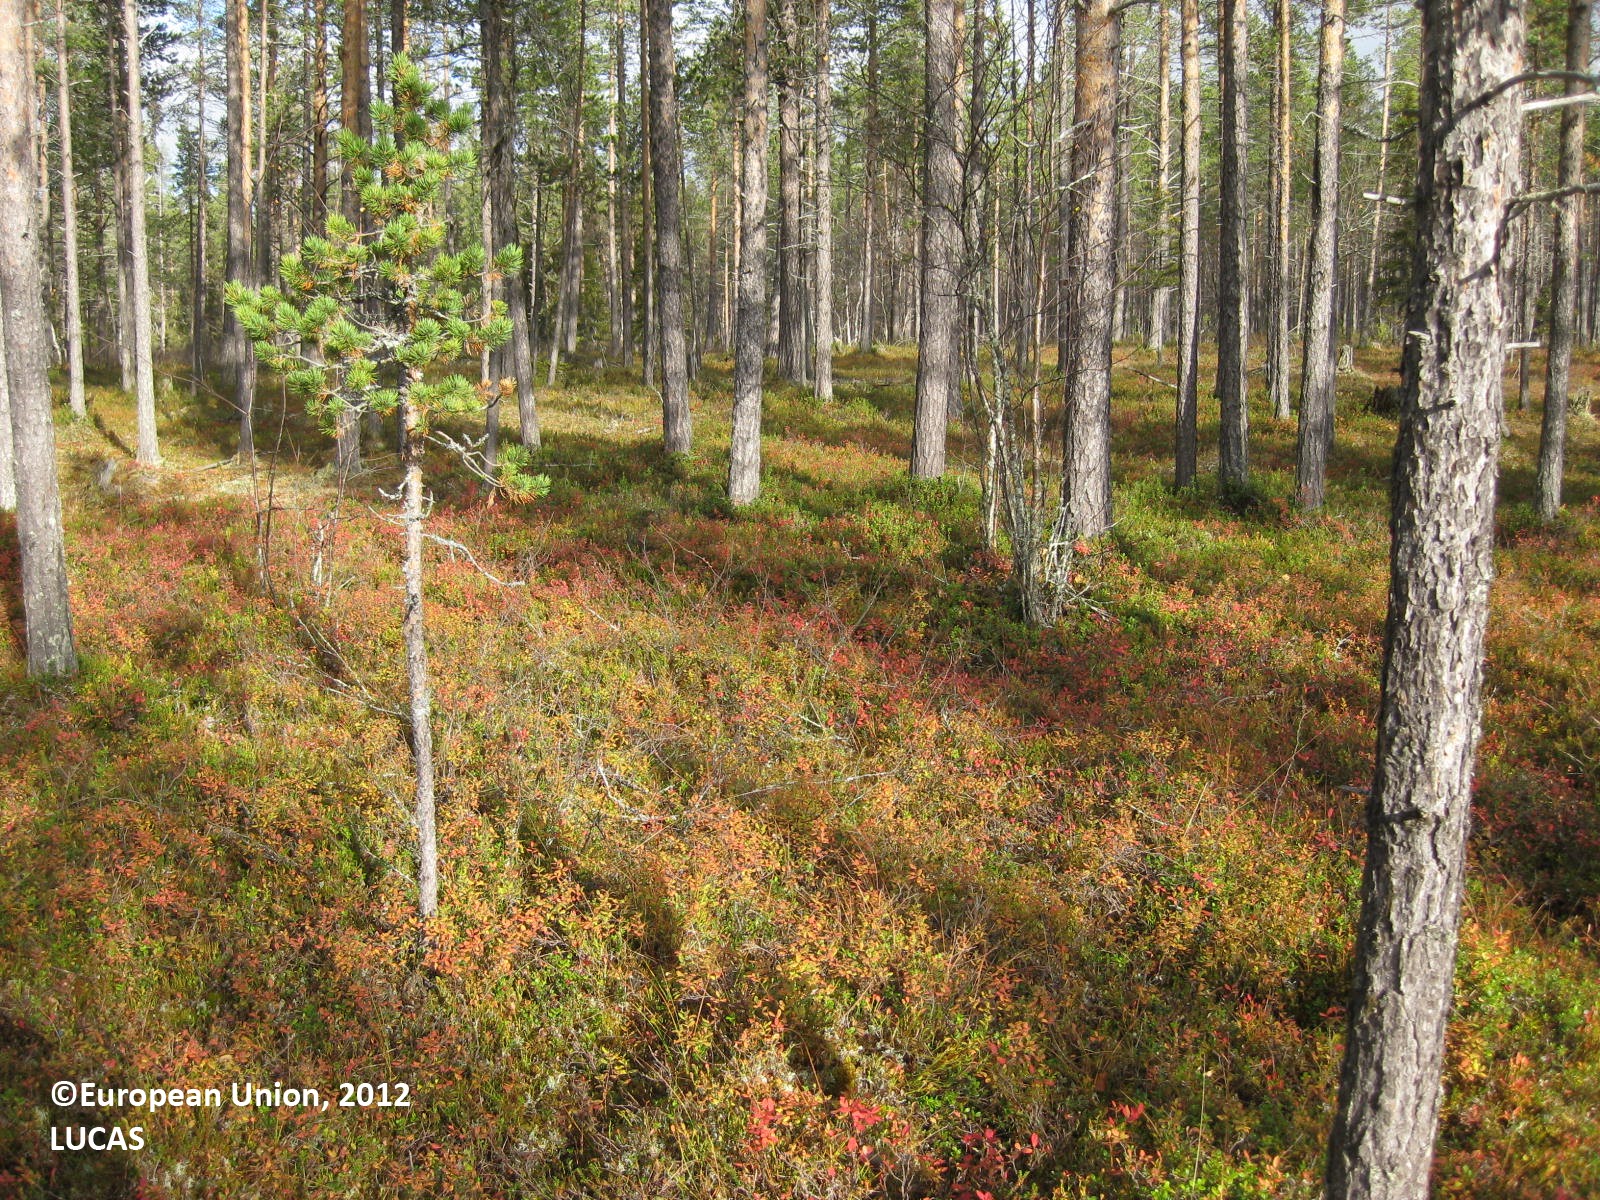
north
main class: Woodland
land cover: Other coniferous woodland
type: boreal forest
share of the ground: > 75 %
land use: Forestry
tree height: > 5 m
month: September
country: FI
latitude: 67.9836
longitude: 23.7090
